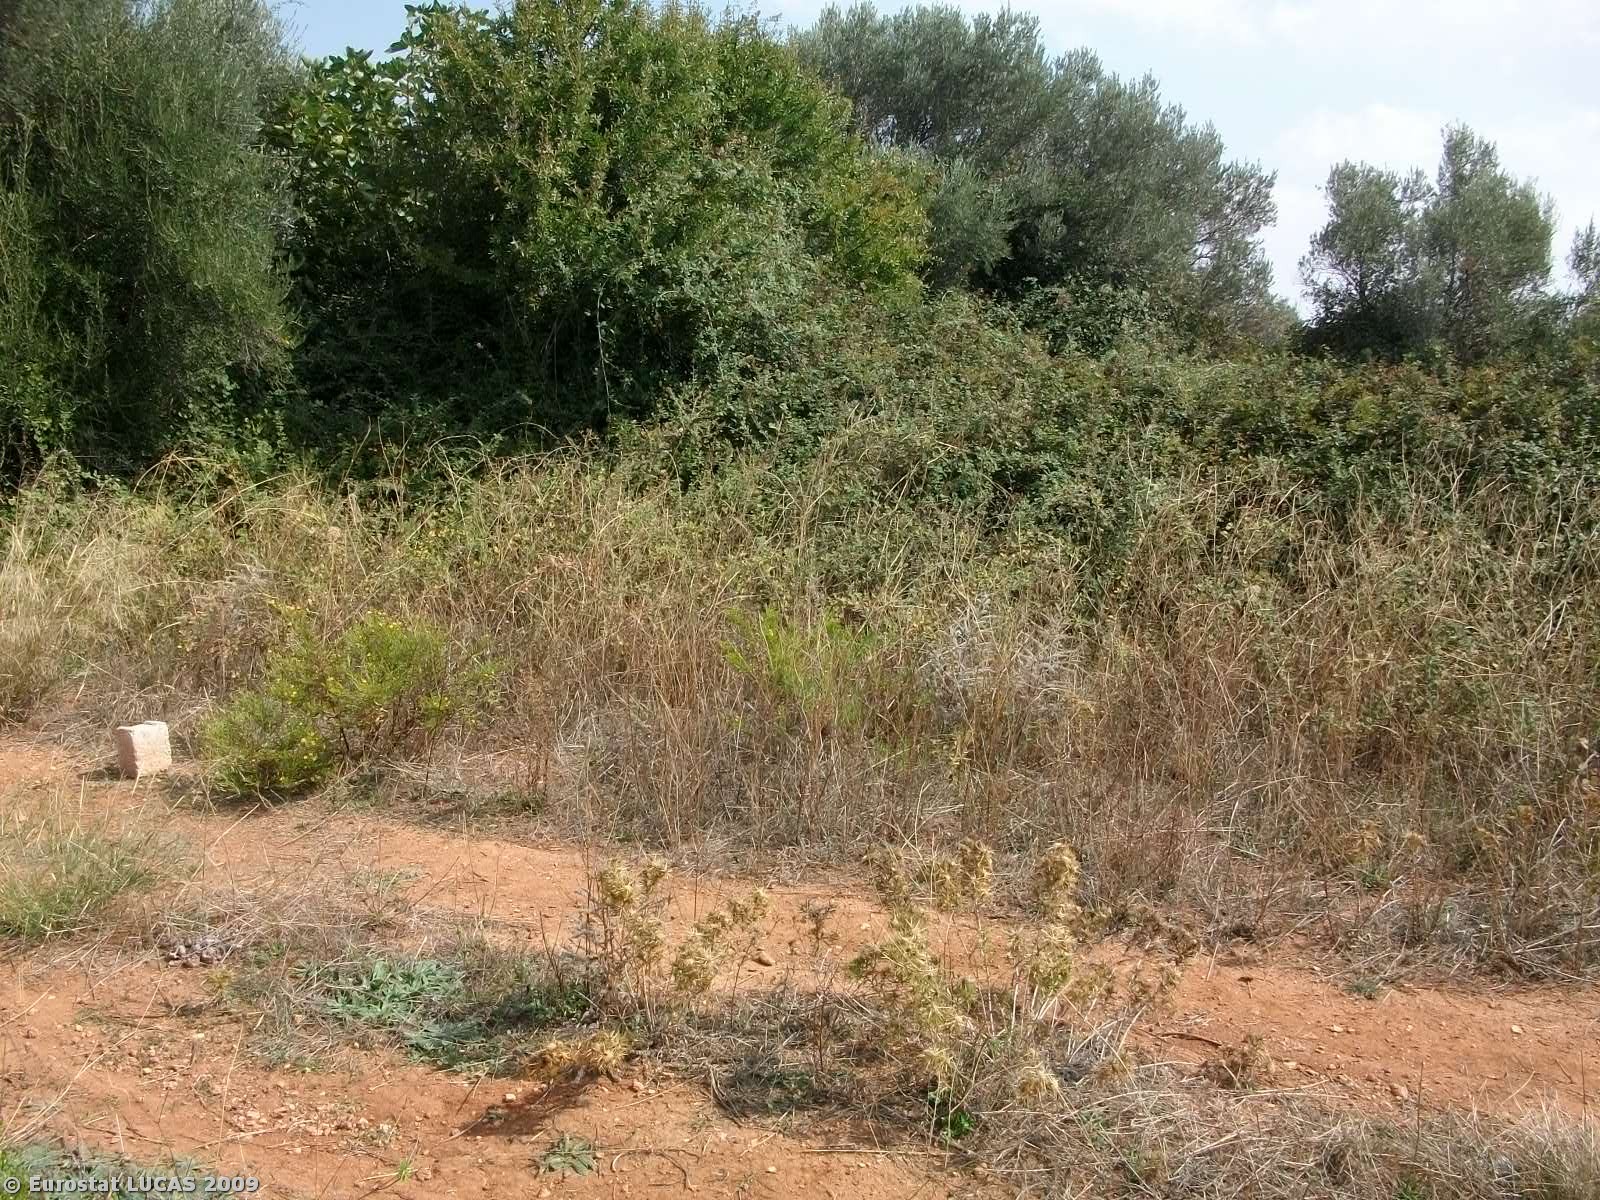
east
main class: Grassland
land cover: Grassland without tree/shrub cover
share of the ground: 50 - 75 %
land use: Agriculture (excluding fallow land and kitchen gardens)
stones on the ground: < 10 %
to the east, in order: Grassland without tree/shrub cover; Tracks; Grass margins; Abandoned hedges; Rivers and streams; Broadleaved woodland; Grassland without tree/shrub cover; Vineyards; Grassland with sparse tree/shrub cover
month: October
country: GR
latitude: 37.9761
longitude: 23.8592
